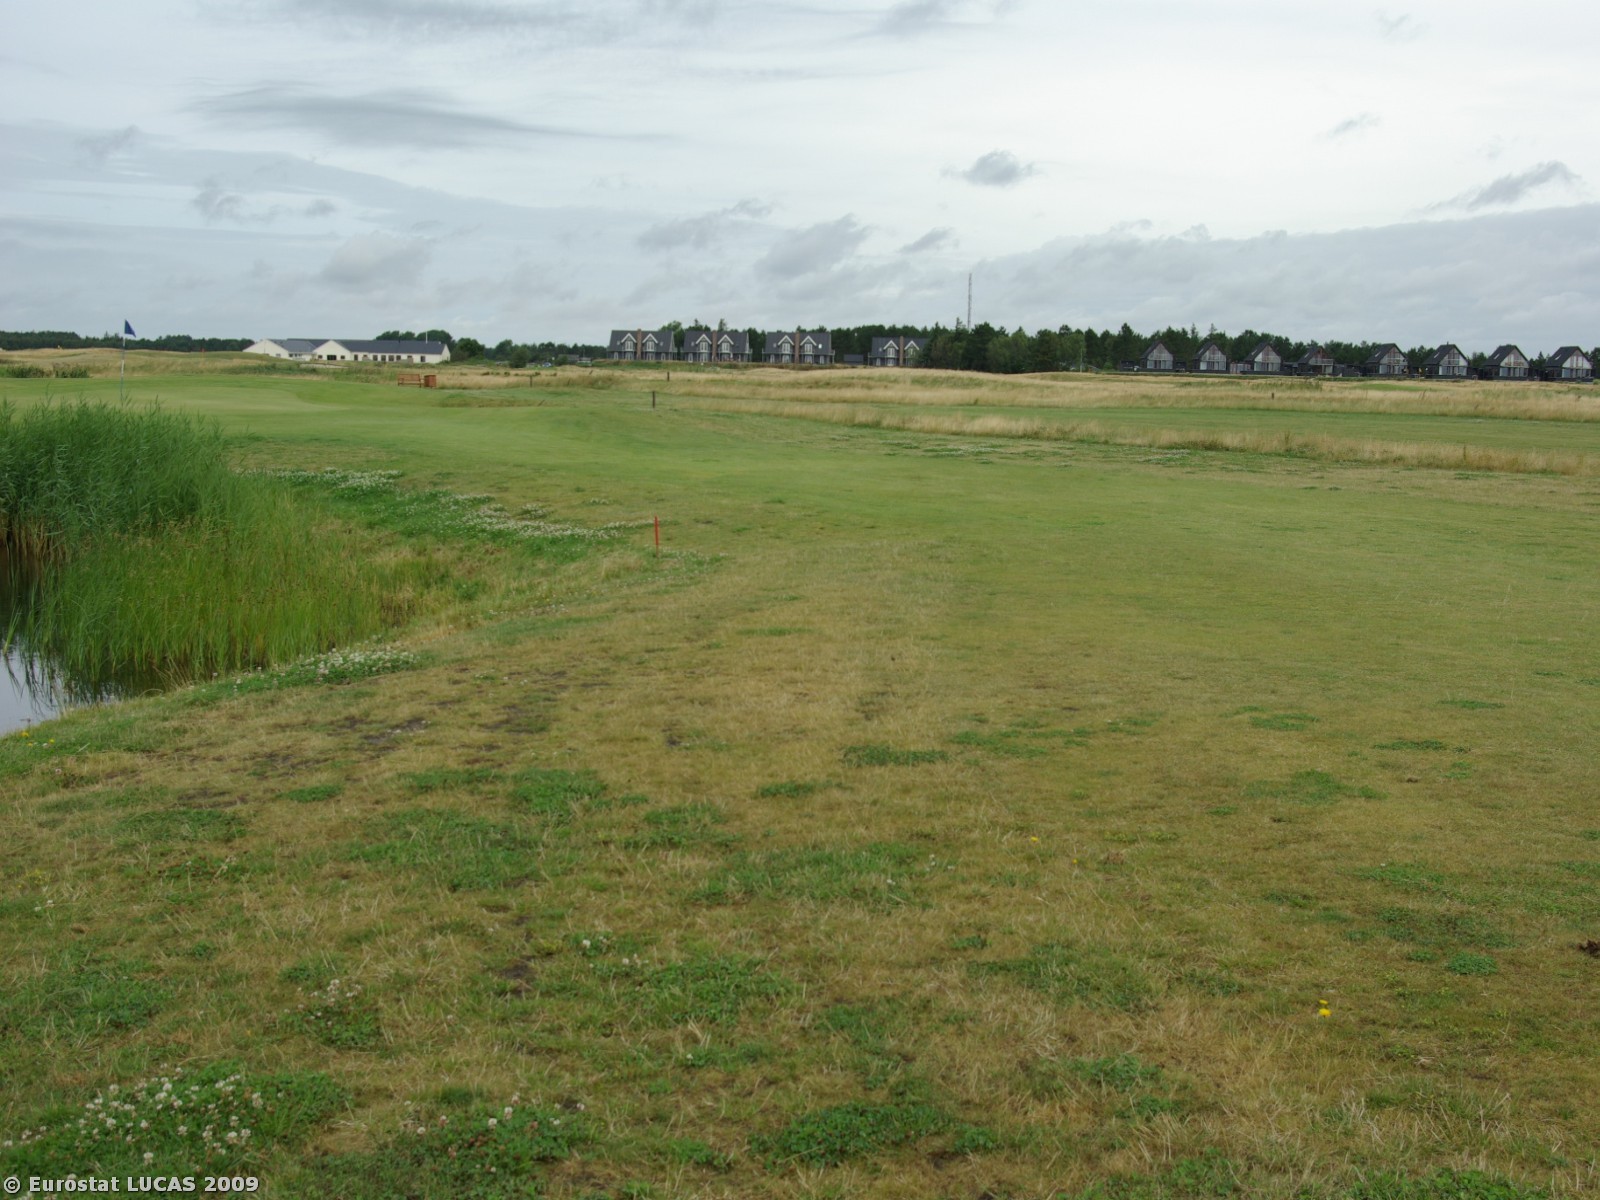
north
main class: Grassland
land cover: Grassland without tree/shrub cover
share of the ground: > 75 %
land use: Sport
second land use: Amenities, museums, leisure
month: July
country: DK
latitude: 55.0829
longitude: 8.5442
